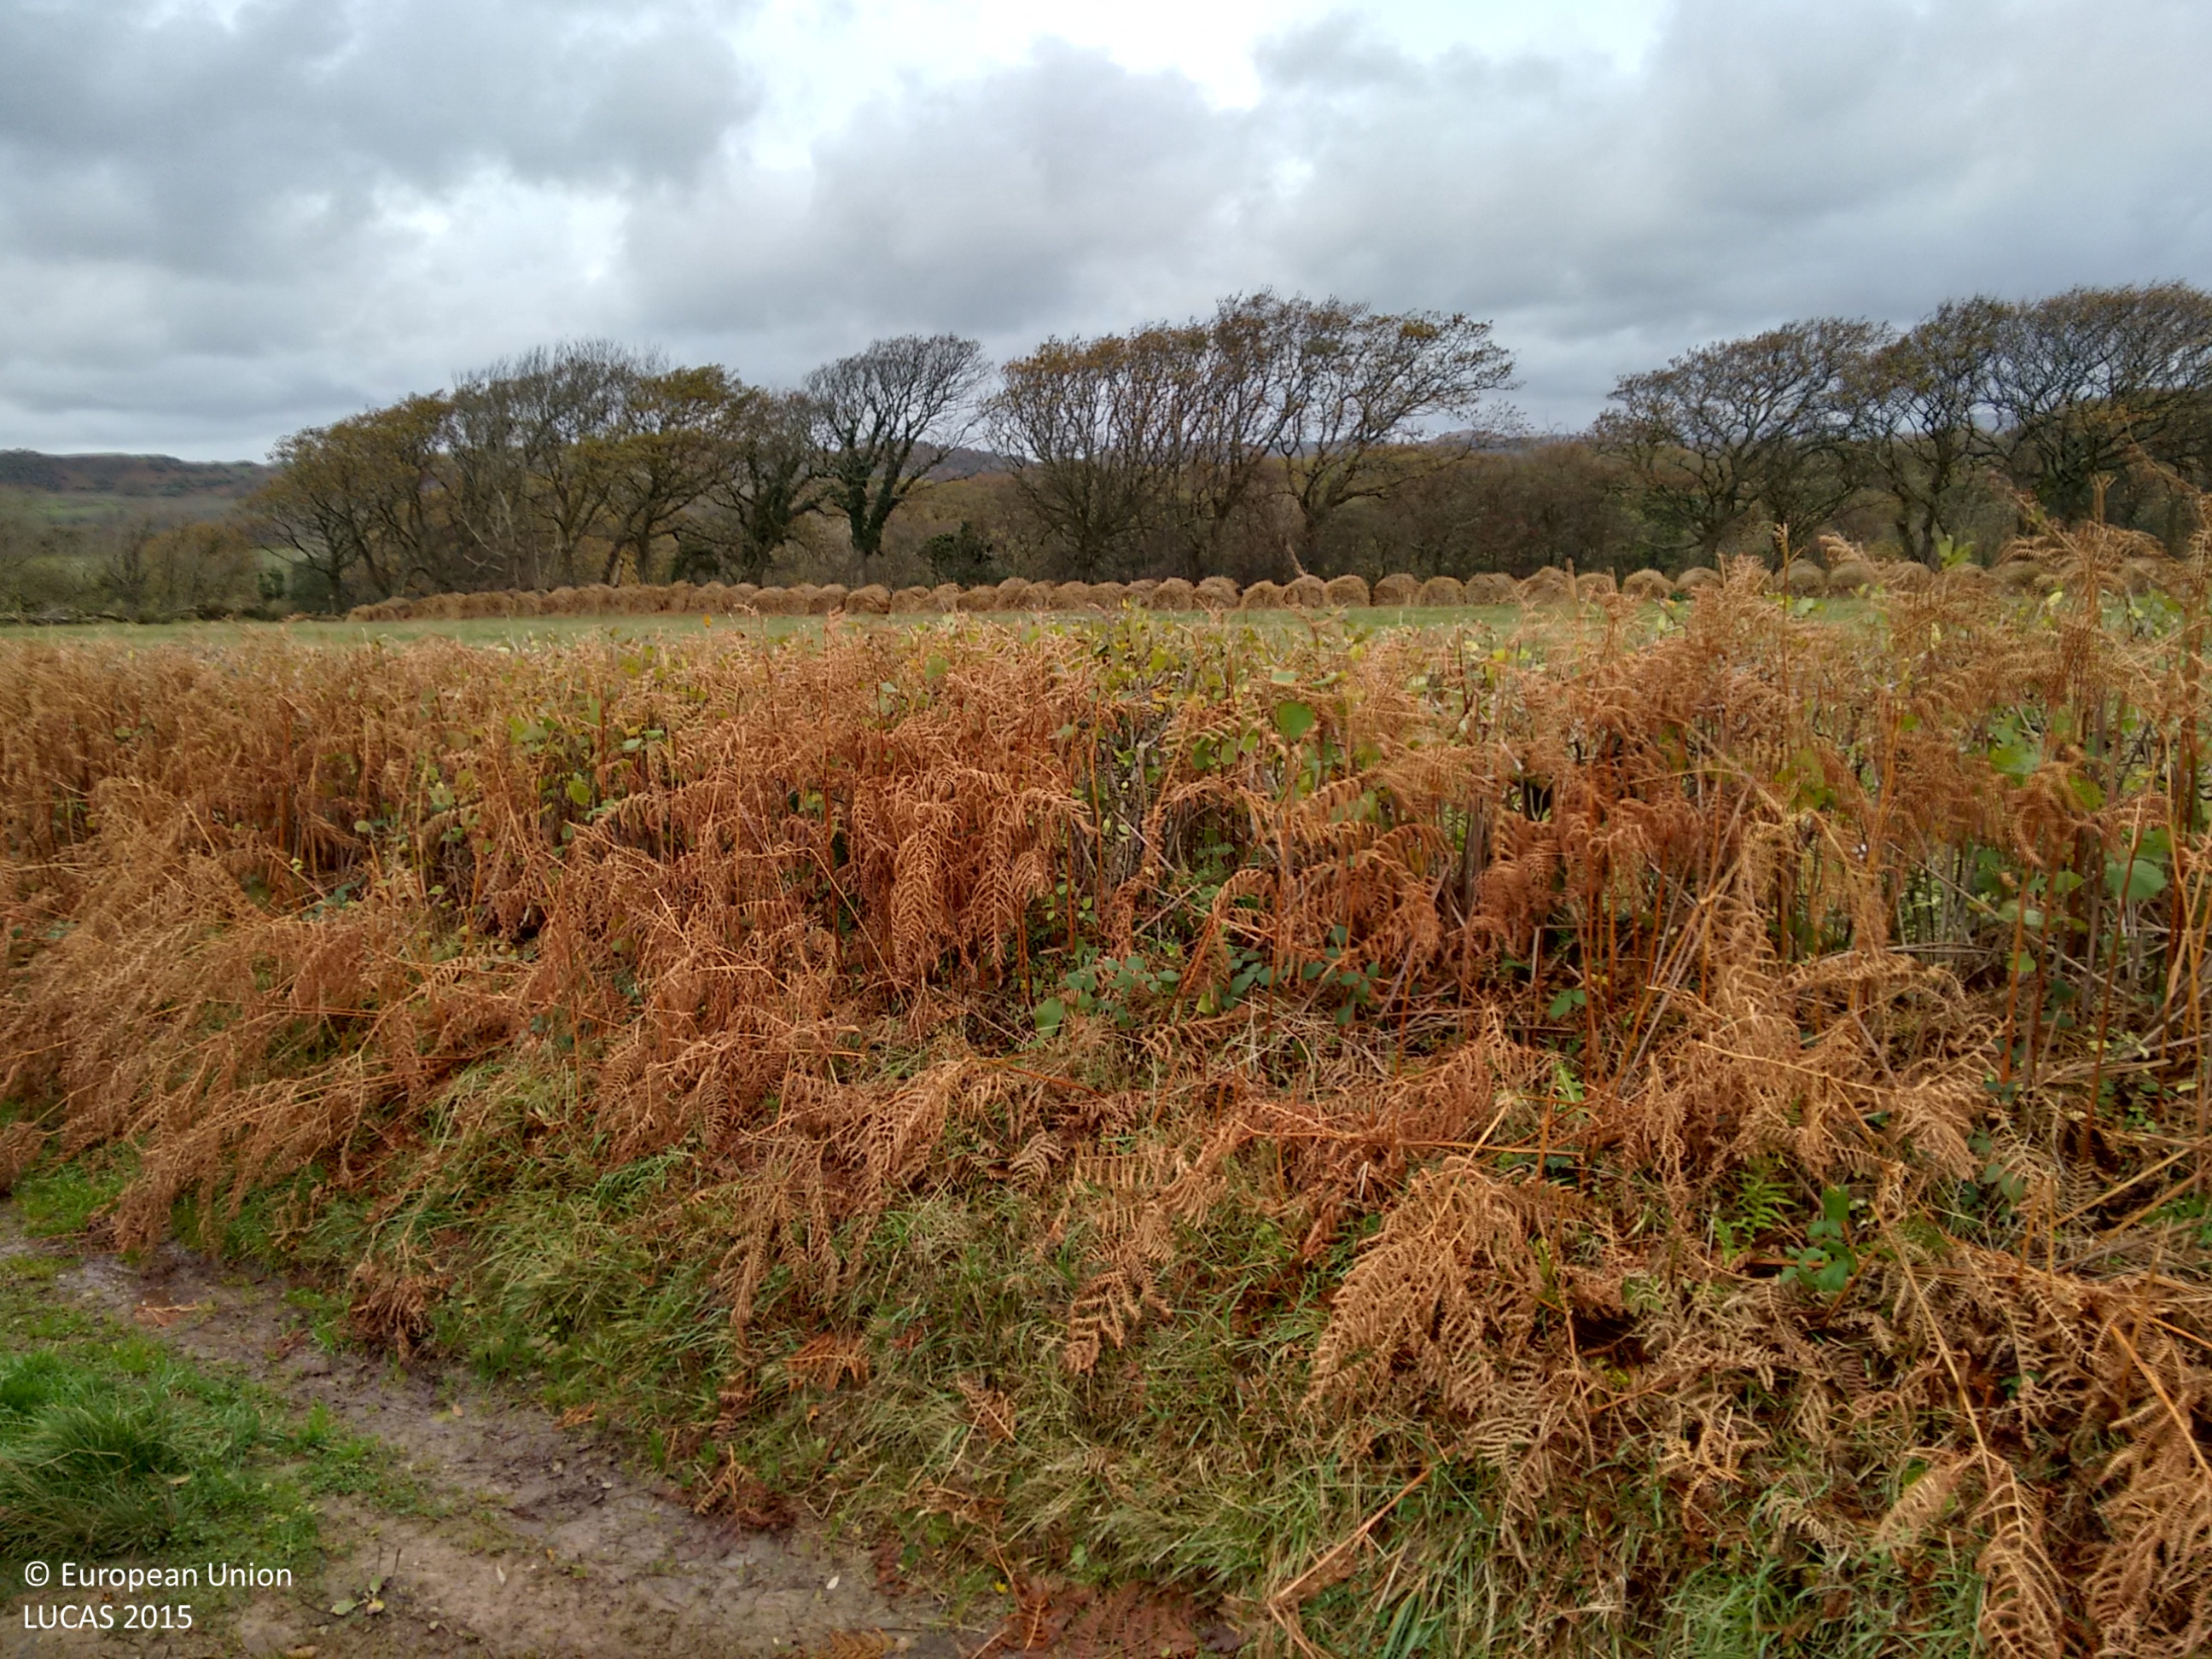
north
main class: Grassland
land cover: Grassland without tree/shrub cover
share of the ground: > 75 %
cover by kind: herbaceous plants 100 %
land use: Agriculture (excluding fallow land and kitchen gardens)
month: November
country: GB
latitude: 54.3329
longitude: -3.3825
